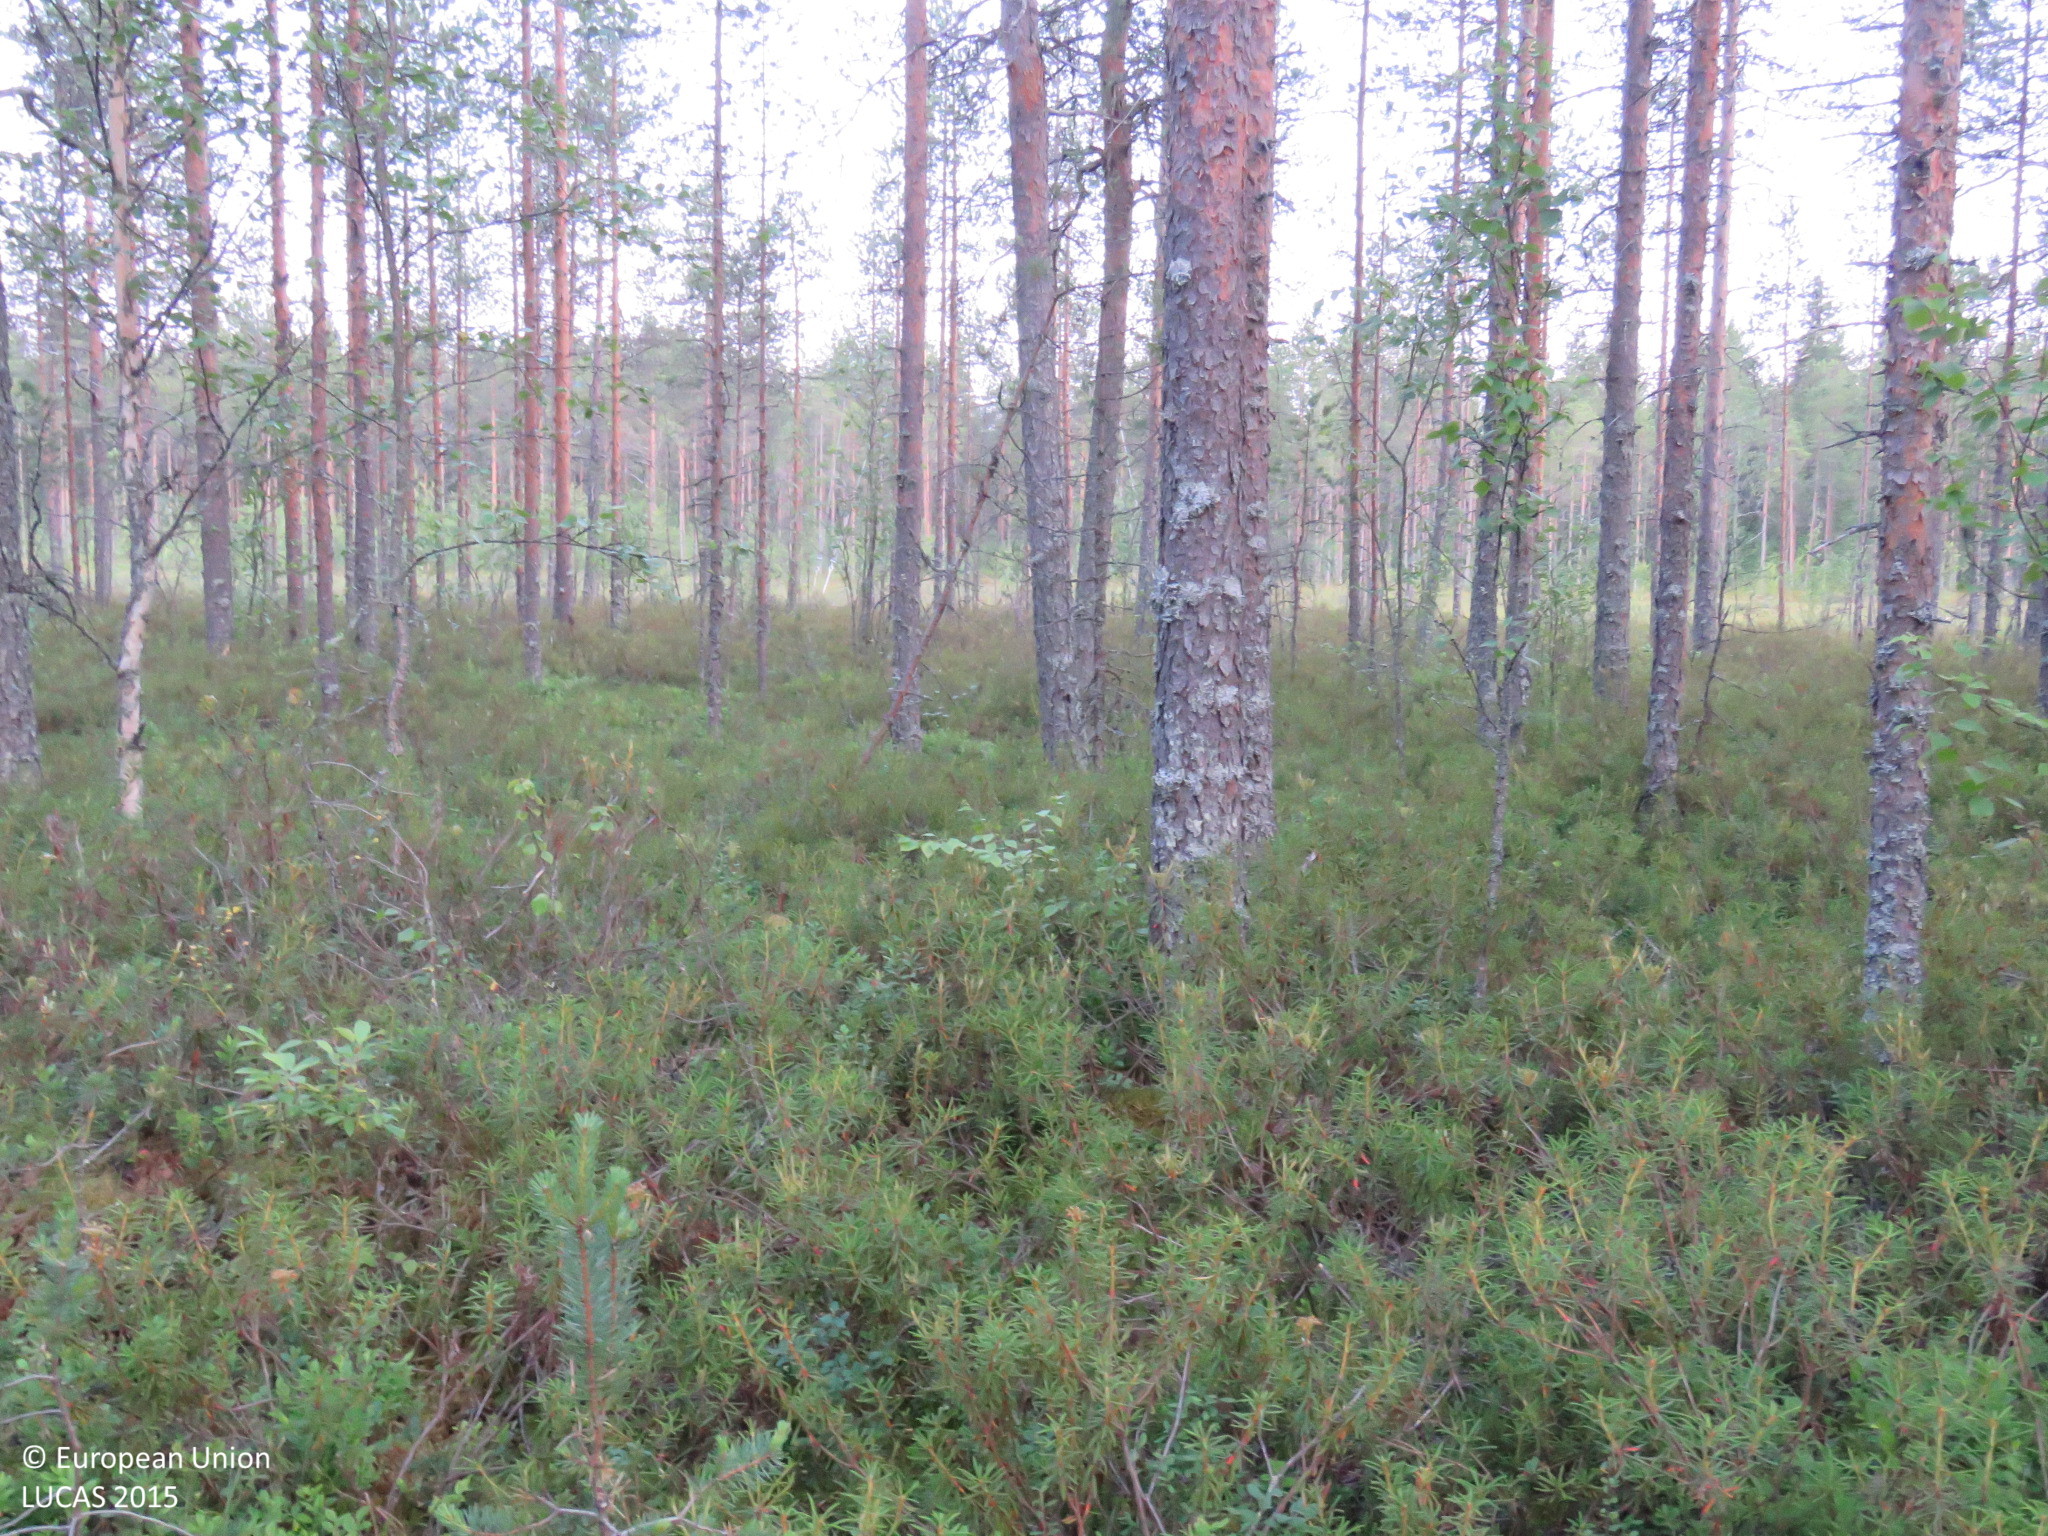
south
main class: Woodland
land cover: Pine dominated coniferous woodland
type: boreal forest
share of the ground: > 75 %
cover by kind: coniferous forest trees 80 %, broadleaved forest trees 10 %, shrubs 10 %
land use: Forestry
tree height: > 5 m
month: July
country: FI
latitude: 64.7684
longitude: 26.3165
